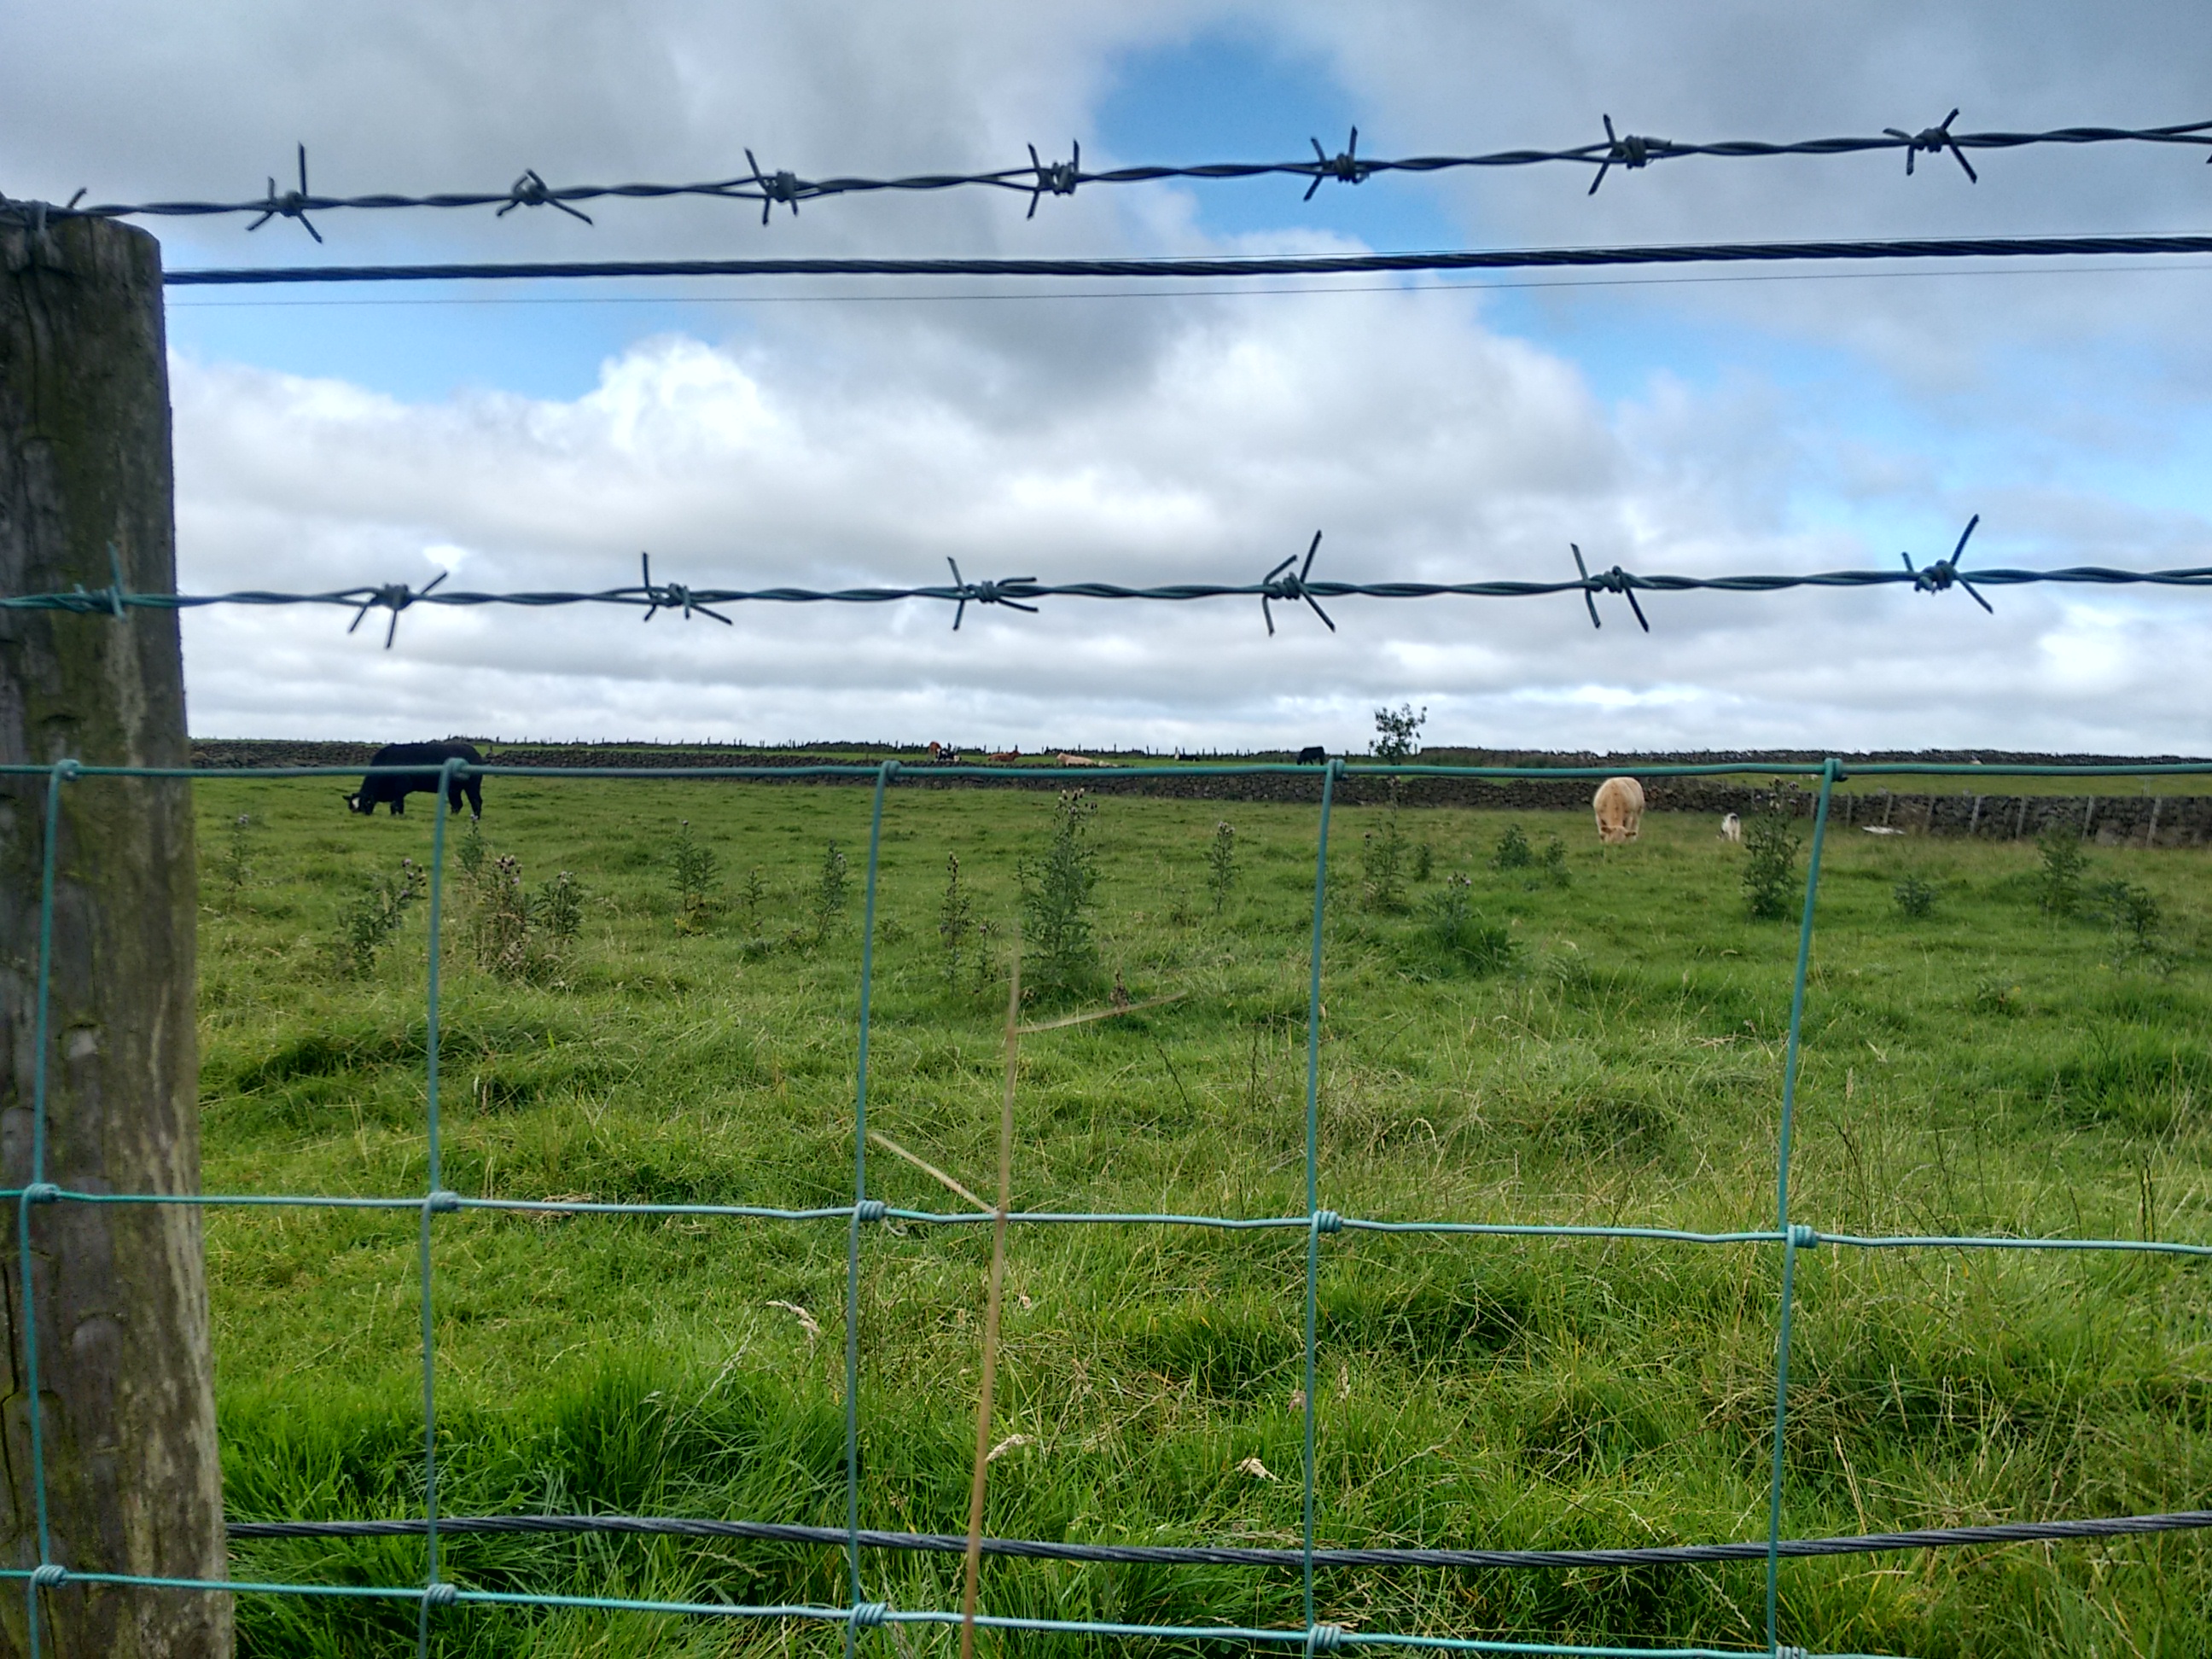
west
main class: Grassland
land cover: Grassland without tree/shrub cover
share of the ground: > 75 %
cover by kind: herbaceous plants 100 %
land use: Agriculture (excluding fallow land and kitchen gardens)
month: September
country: GB
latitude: 54.9081
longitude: -6.0665
